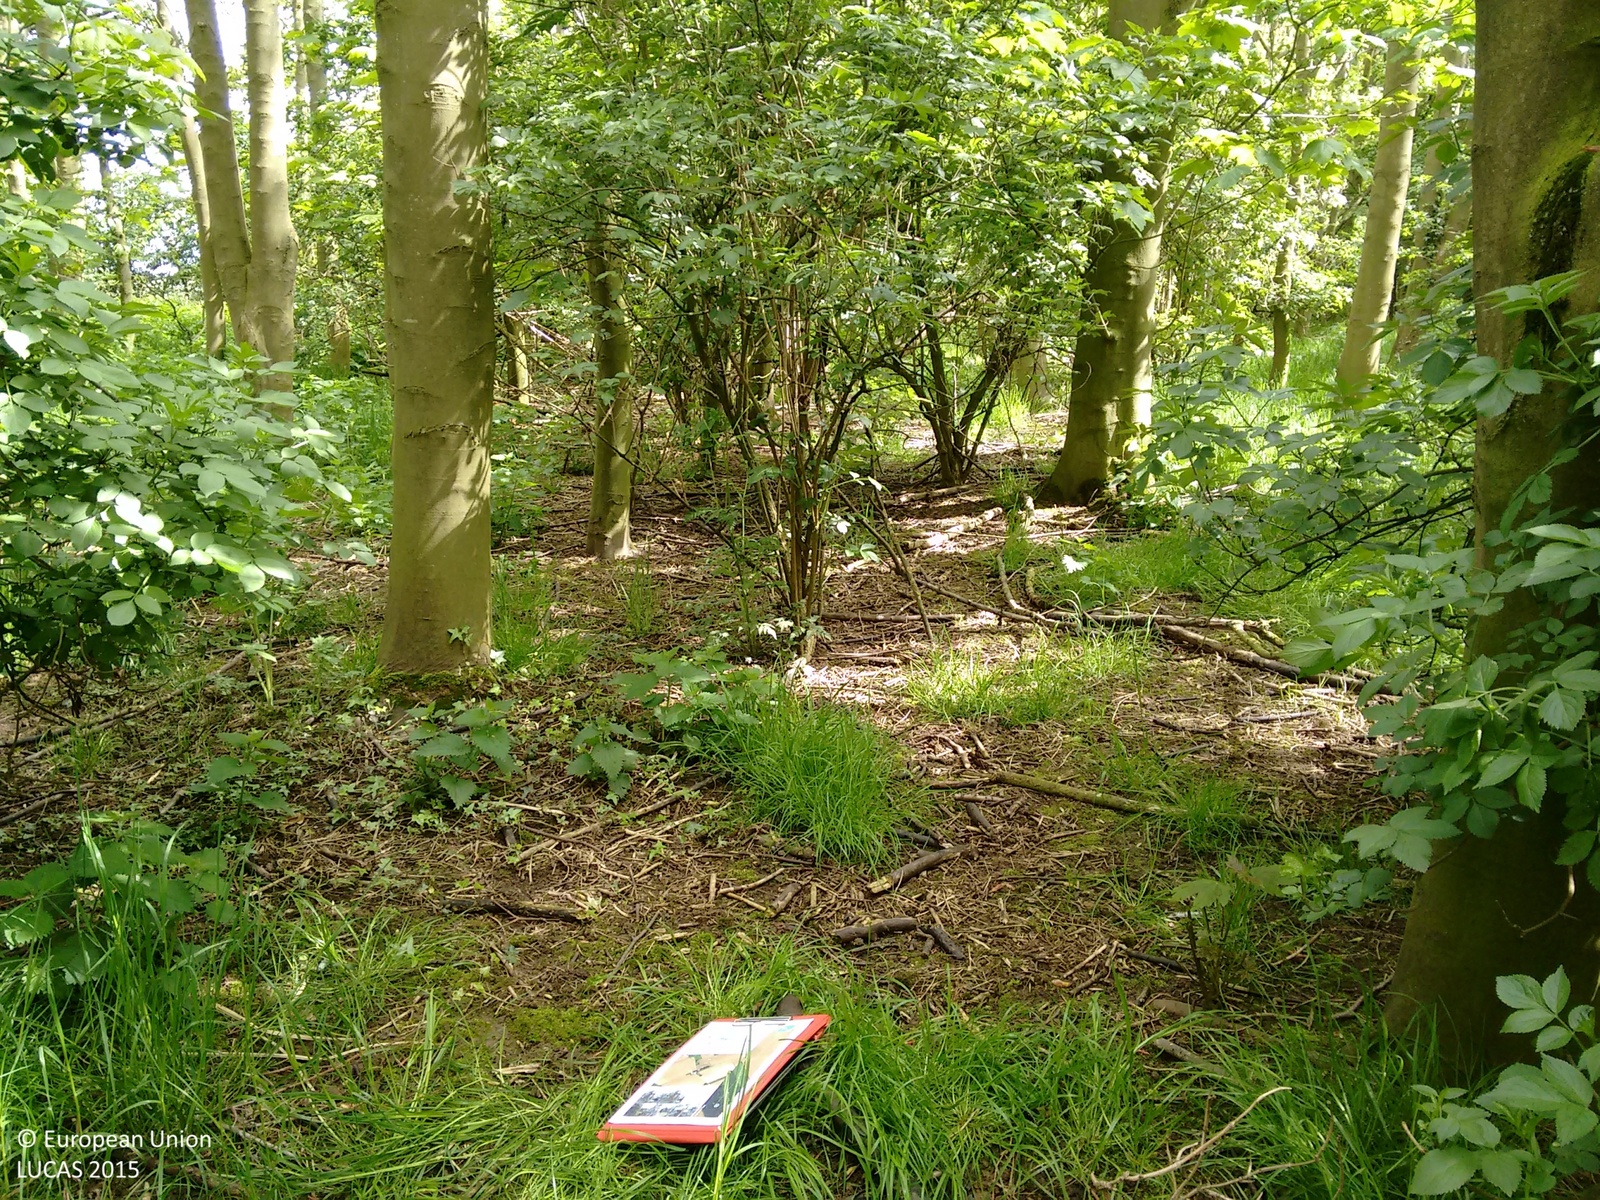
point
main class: Woodland
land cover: Broadleaved woodland
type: mesophytic deciduous forest
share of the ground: > 75 %
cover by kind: broadleaved forest trees 100 %
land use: Agriculture (excluding fallow land and kitchen gardens)
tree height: > 5 m
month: May
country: GB
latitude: 53.1005
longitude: 0.2777
